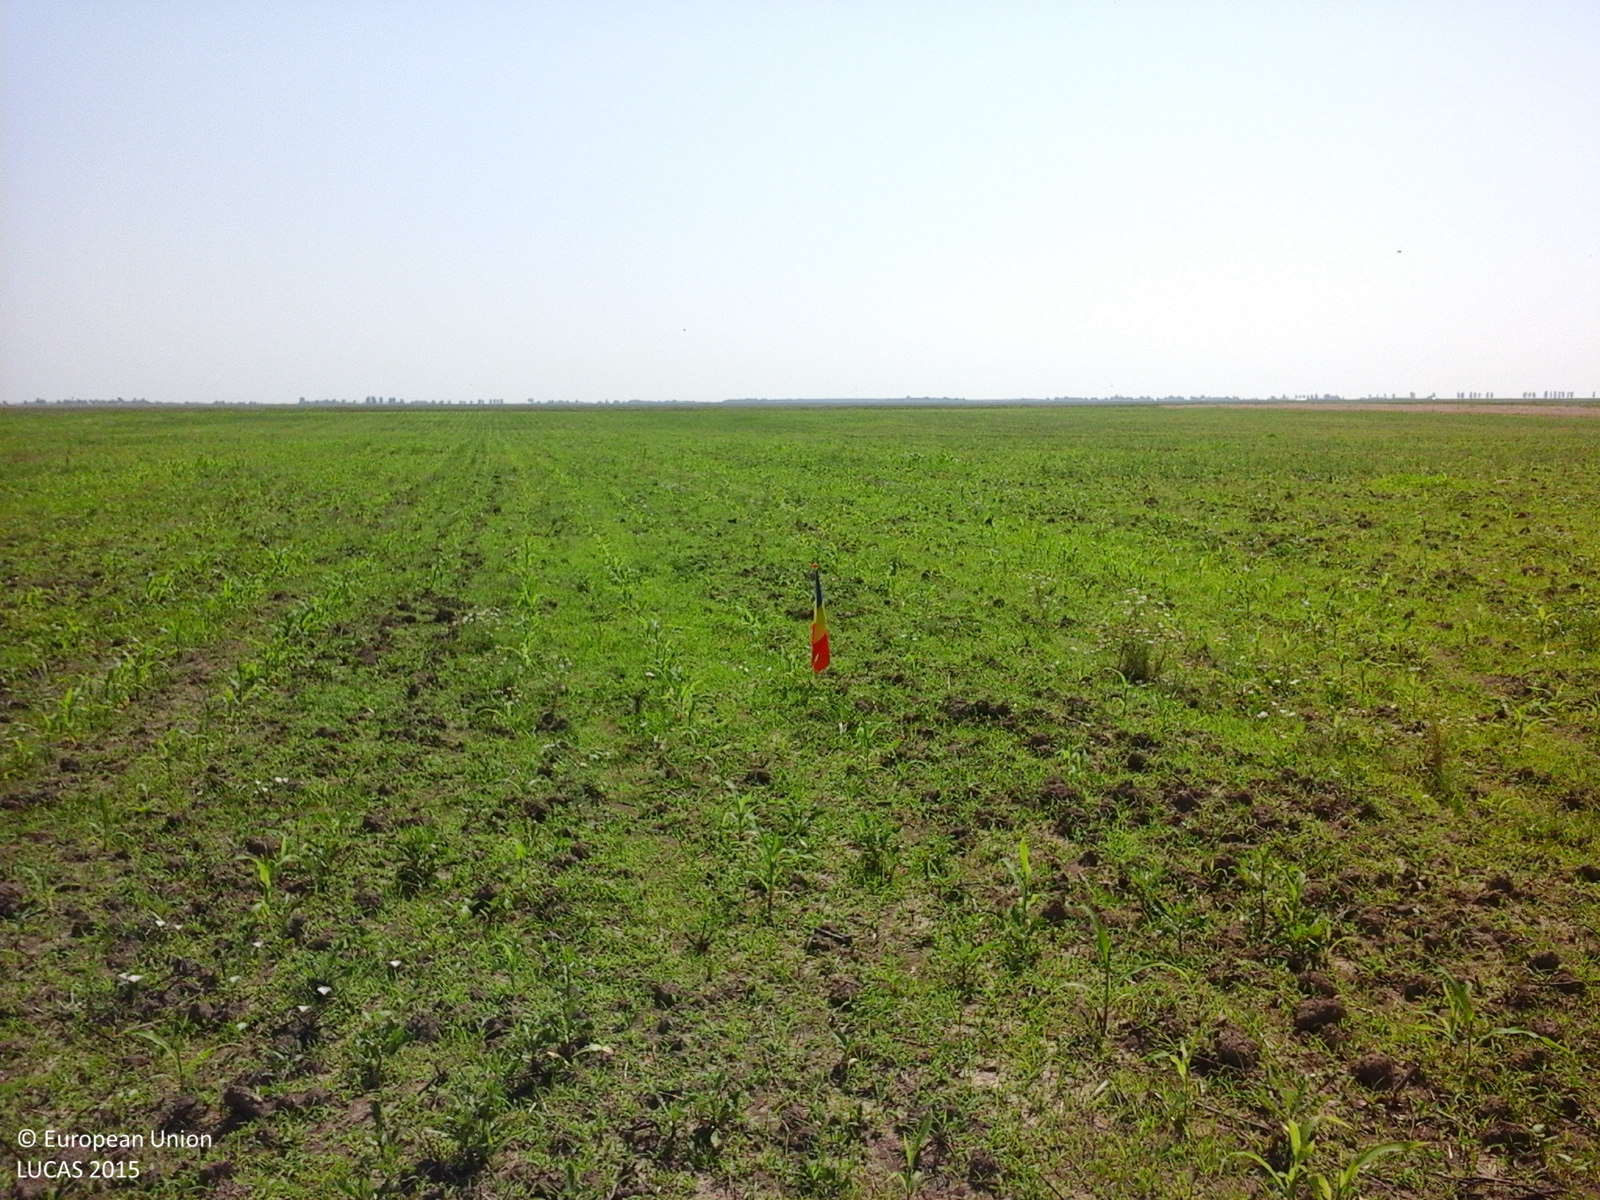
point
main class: Cropland
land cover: Maize
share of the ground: < 10 %
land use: Agriculture (excluding fallow land and kitchen gardens)
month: July
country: RO
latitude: 44.5292
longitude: 24.9152
